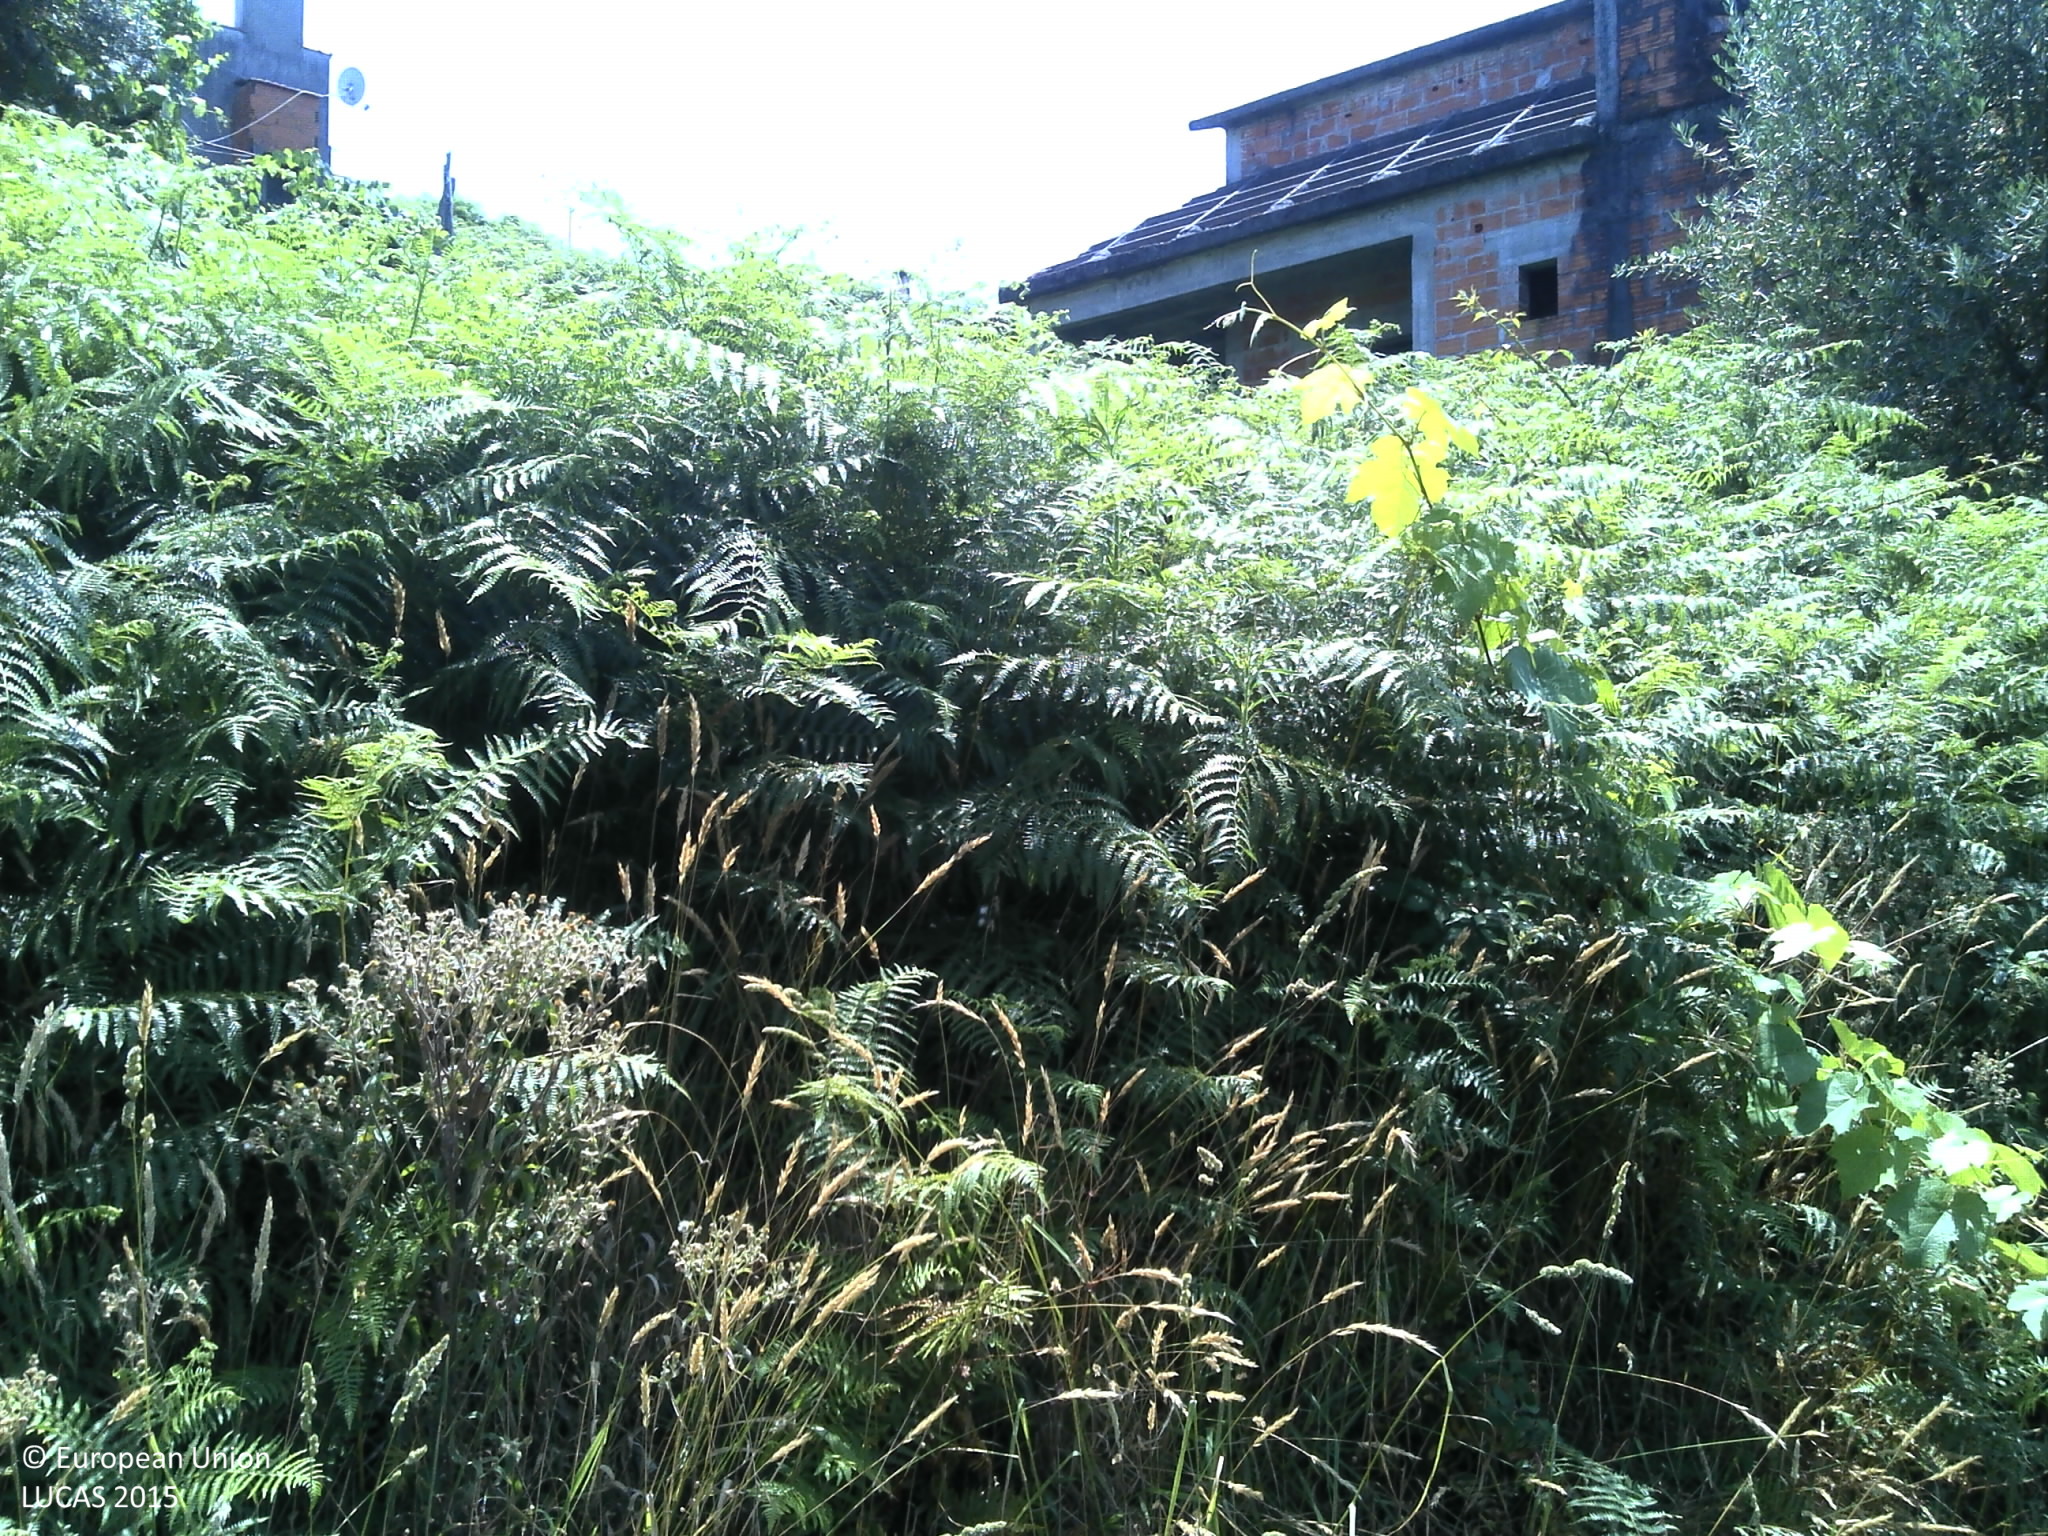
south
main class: Cropland
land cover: Vineyards
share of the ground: 25 - 50 %
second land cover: Grassland without tree/shrub cover
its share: 25 - 50 %
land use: Agriculture (excluding fallow land and kitchen gardens)
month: June
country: PT
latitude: 40.7144
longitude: -8.2825
